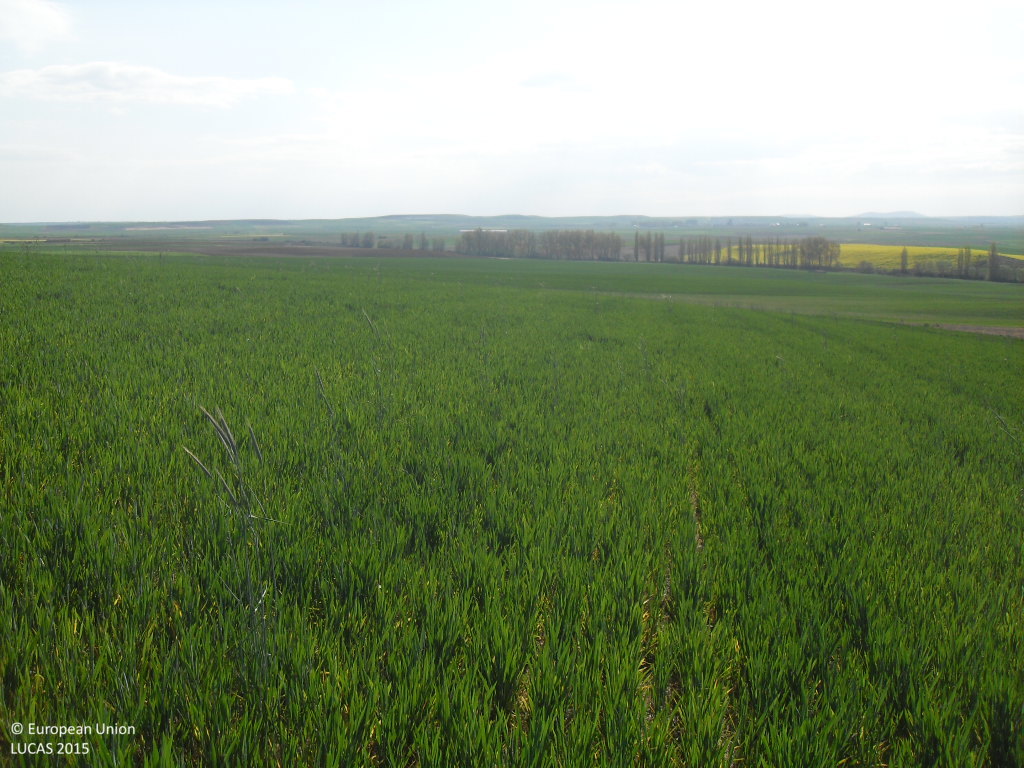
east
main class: Cropland
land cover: Common wheat
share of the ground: > 75 %
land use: Agriculture (excluding fallow land and kitchen gardens)
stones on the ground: < 10 %
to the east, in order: Common wheat; Grass margins; Tracks; Grass margins; Oats; Common wheat
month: April
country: ES
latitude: 40.8081
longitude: -5.2766
